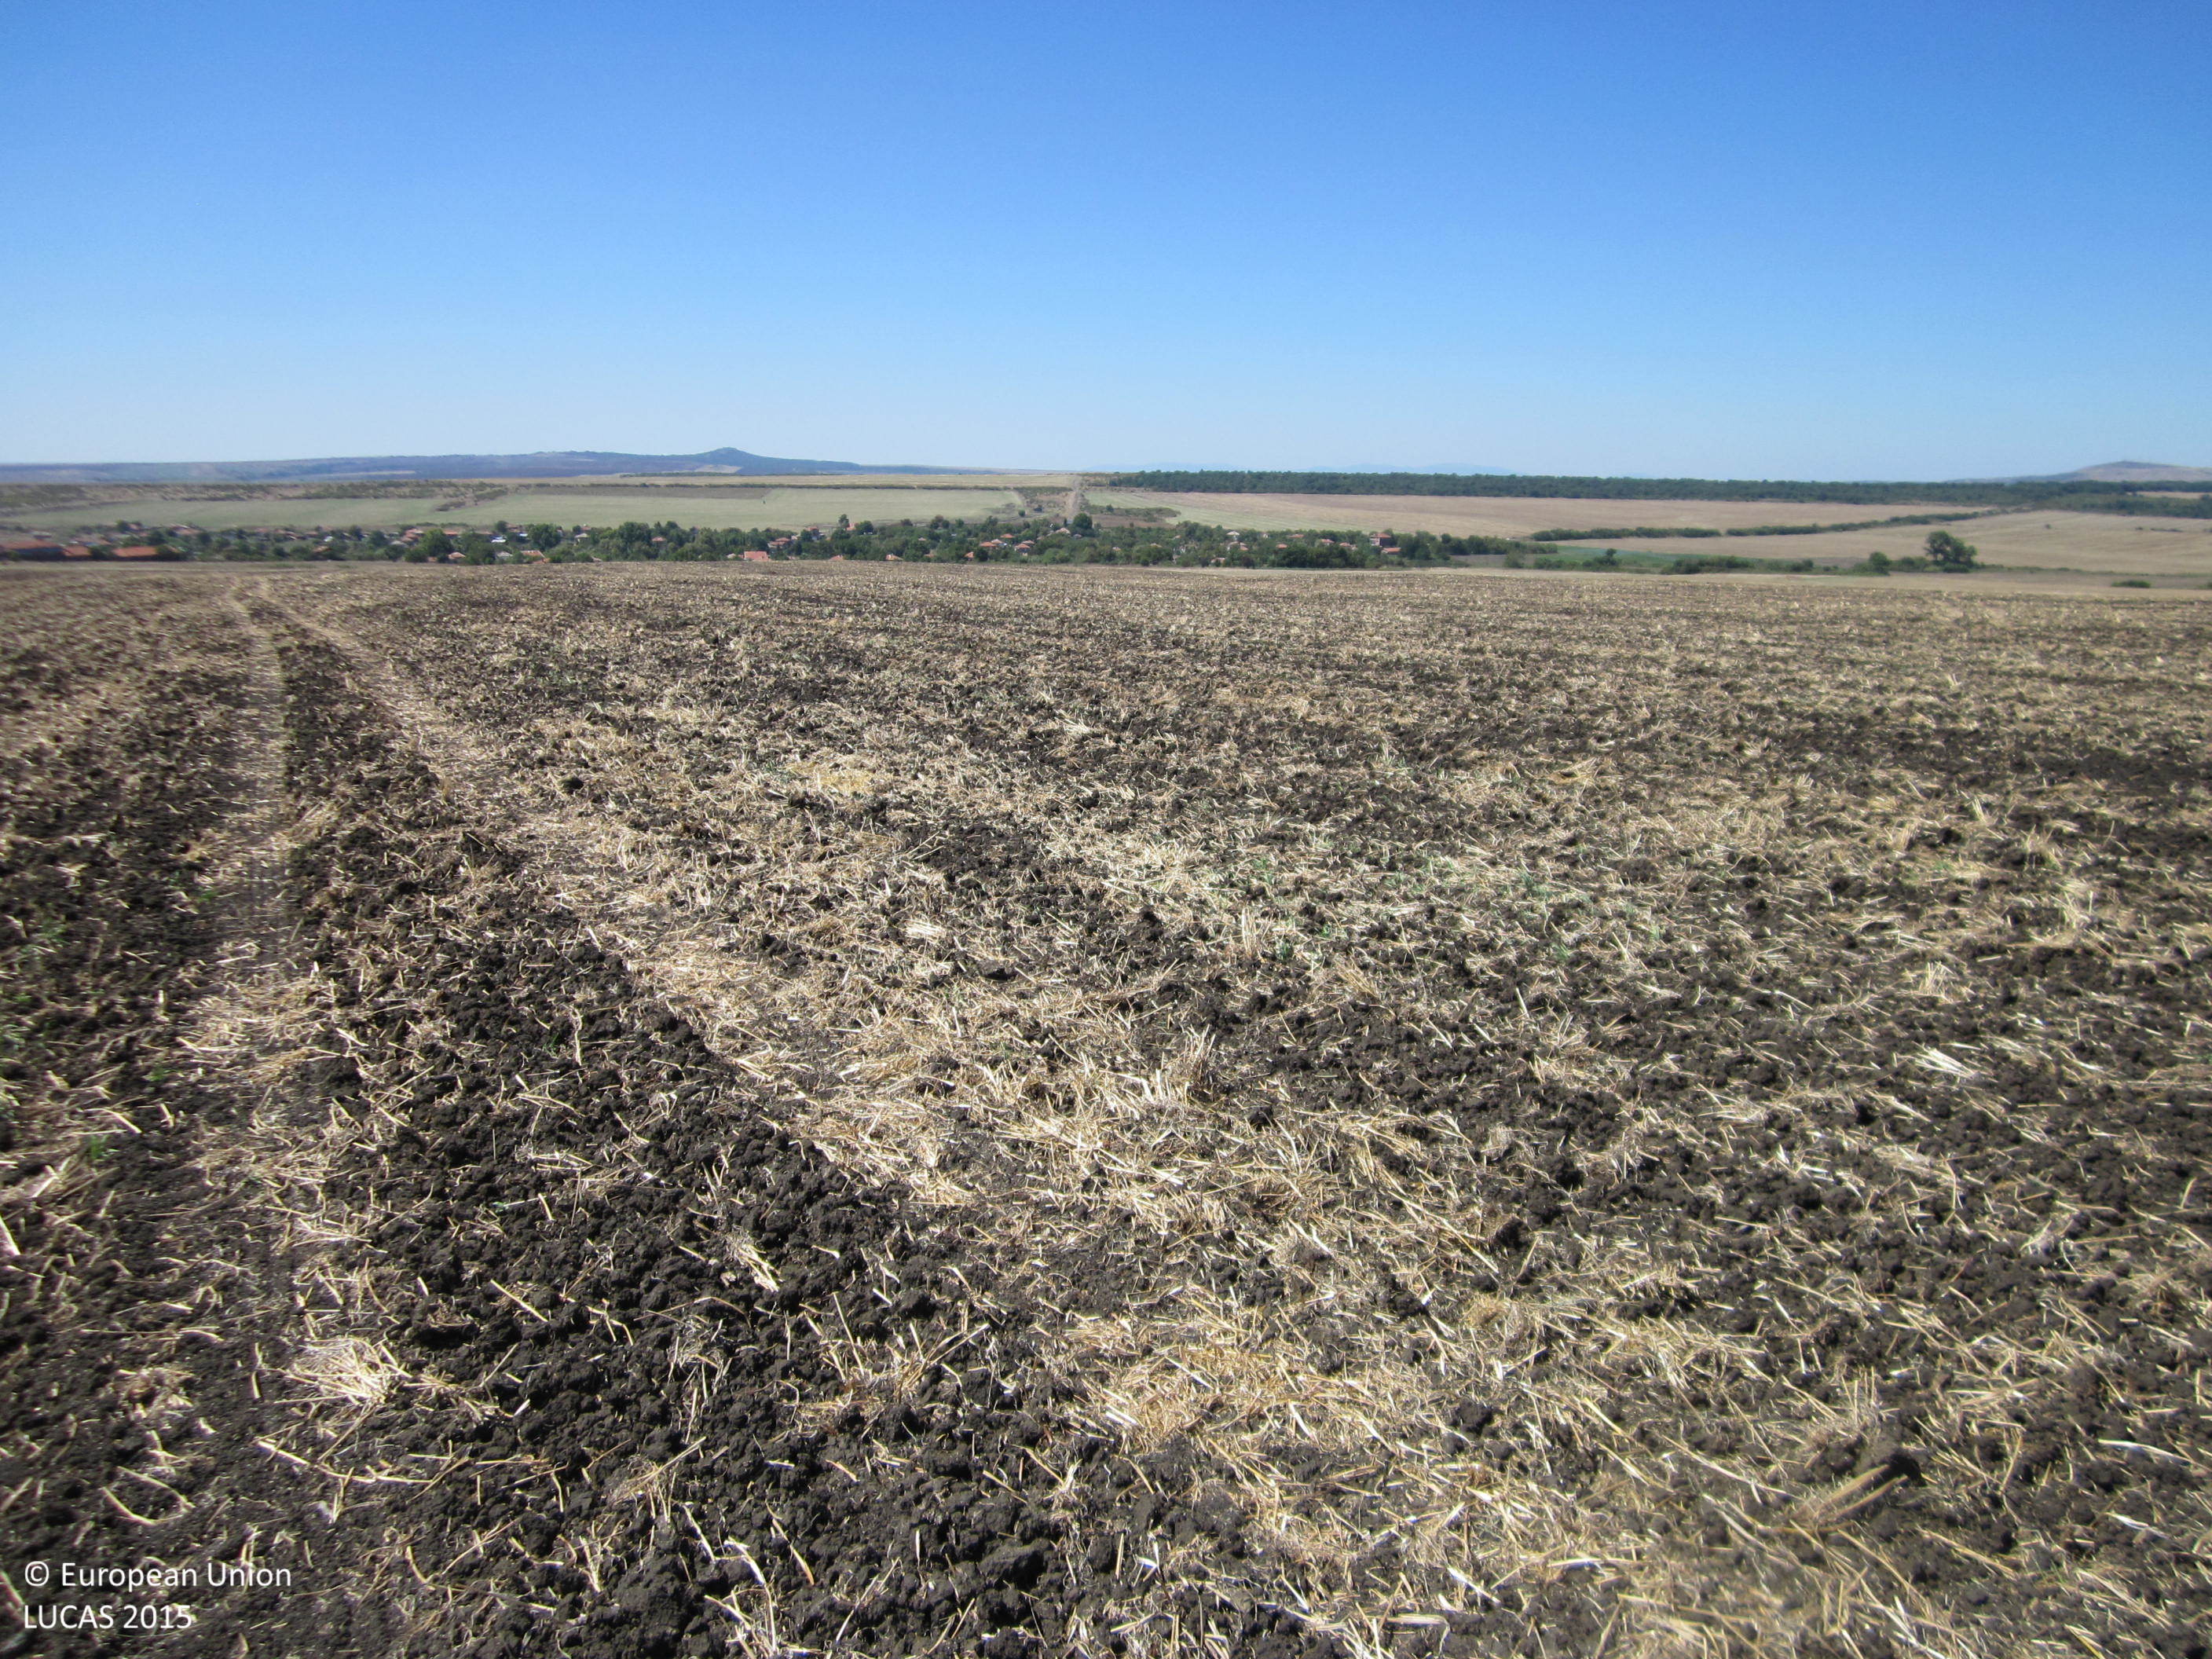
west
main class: Cropland
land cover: Common wheat
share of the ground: 10 - 25 %
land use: Agriculture (excluding fallow land and kitchen gardens)
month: September
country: BG
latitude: 42.5587
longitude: 27.0490
